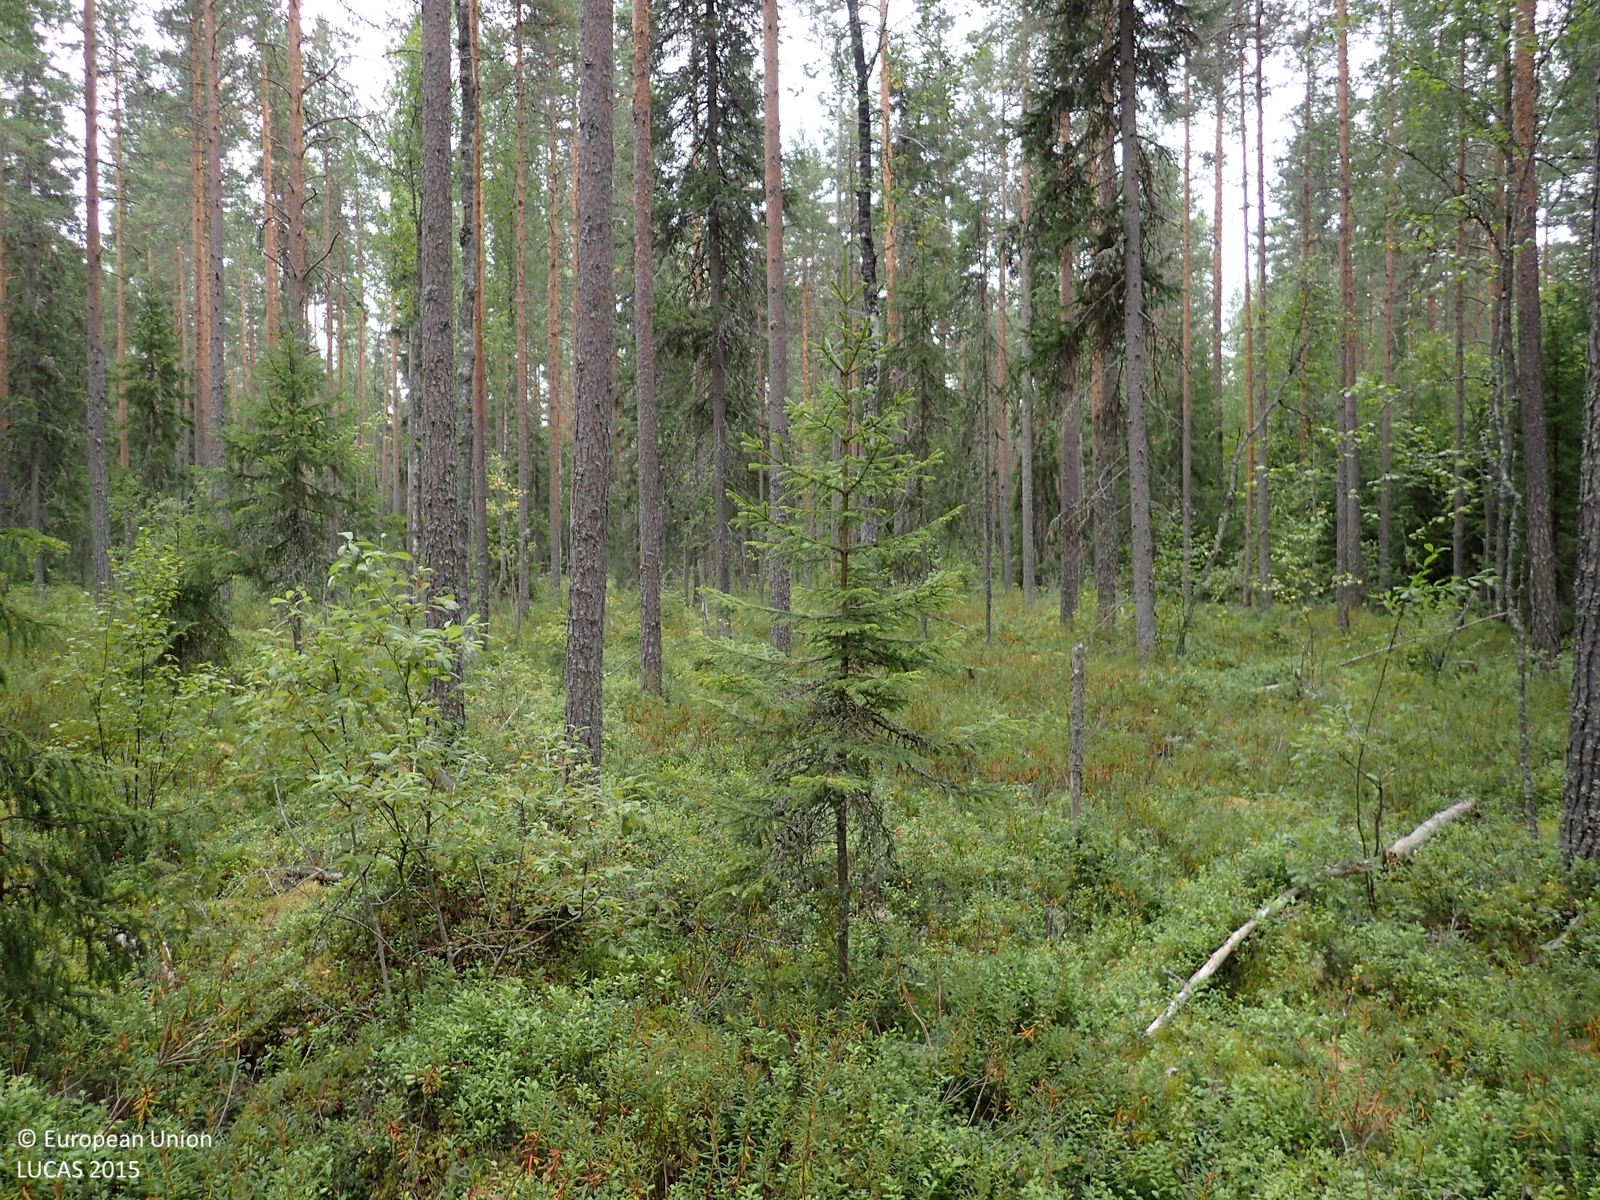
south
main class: Woodland
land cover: Other coniferous woodland
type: boreal forest
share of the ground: > 75 %
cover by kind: coniferous forest trees 70 %, shrubs 20 %, broadleaved forest trees 5 %, lichens and mosses 5 %
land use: Forestry
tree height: > 5 m
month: August
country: FI
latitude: 62.6592
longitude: 22.6842
